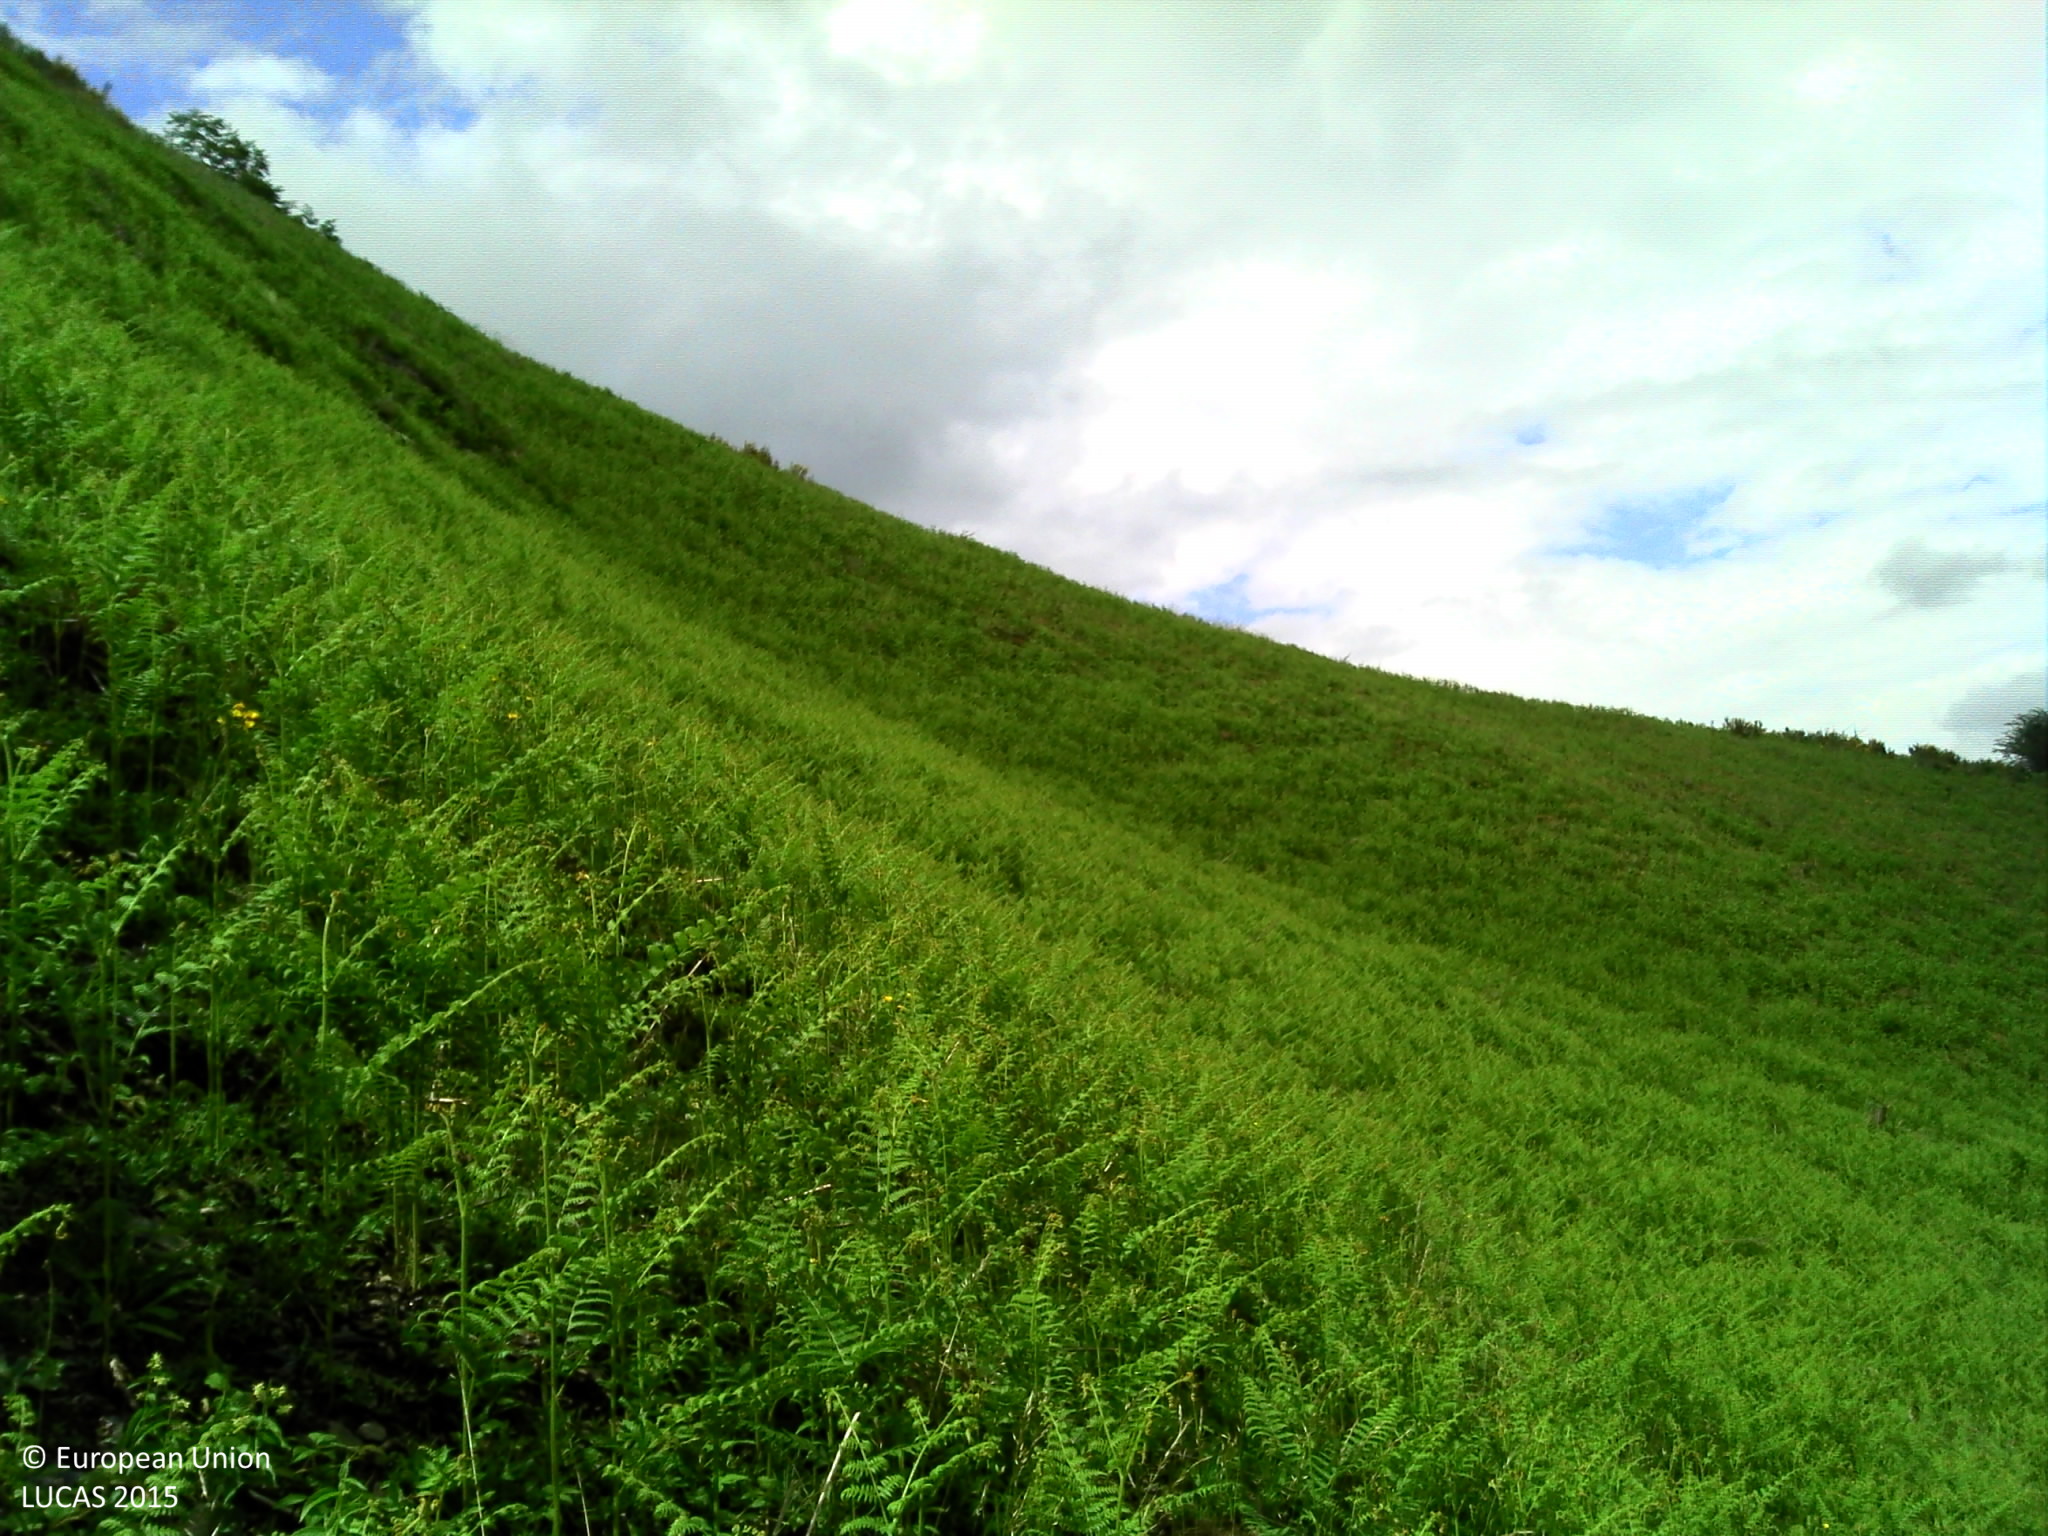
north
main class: Grassland
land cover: Grassland without tree/shrub cover
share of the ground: > 75 %
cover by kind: herbaceous plants 100 %
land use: Agriculture (excluding fallow land and kitchen gardens)
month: June
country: FR
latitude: 42.9123
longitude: -0.6262
